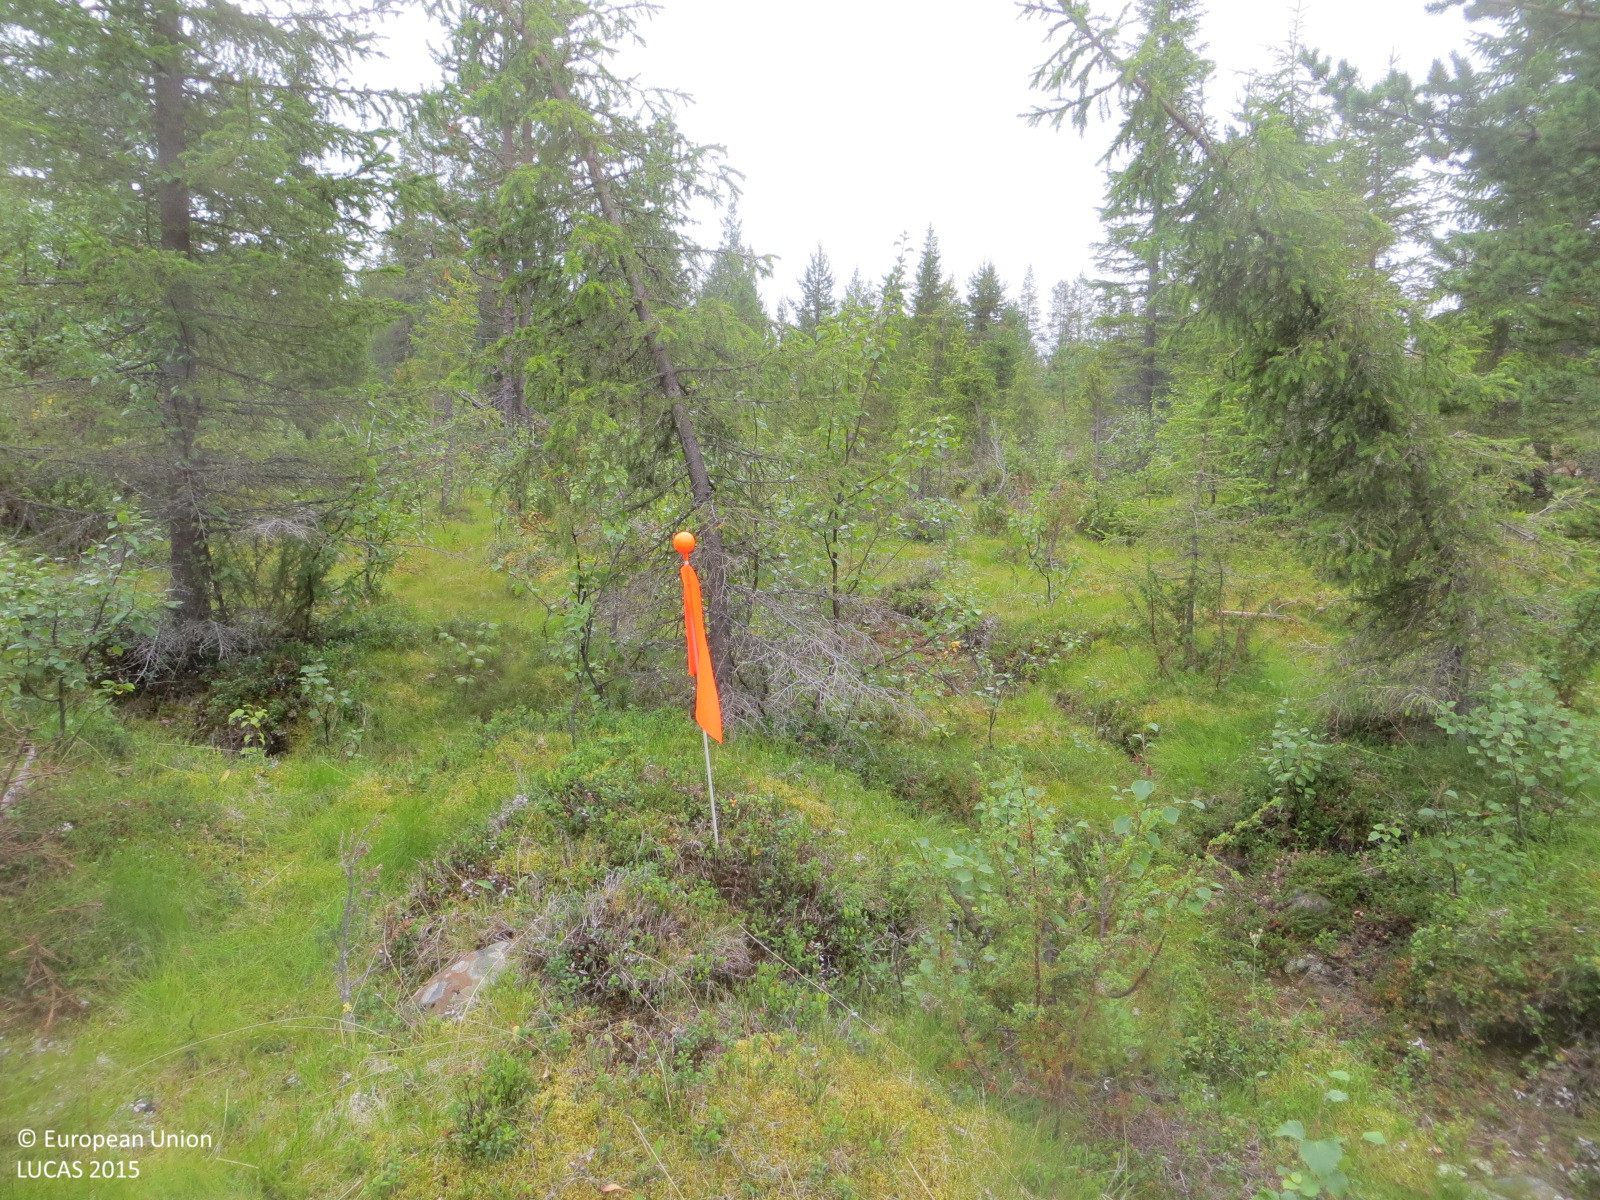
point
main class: Woodland
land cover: Spruce dominated coniferous woodland
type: boreal forest
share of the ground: 50 - 75 %
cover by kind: coniferous forest trees 50 %, herbaceous plants 25 %, shrubs 20 %, broadleaved forest trees 5 %
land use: Forestry
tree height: > 5 m
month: August
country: FI
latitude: 68.0351
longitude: 25.3463
